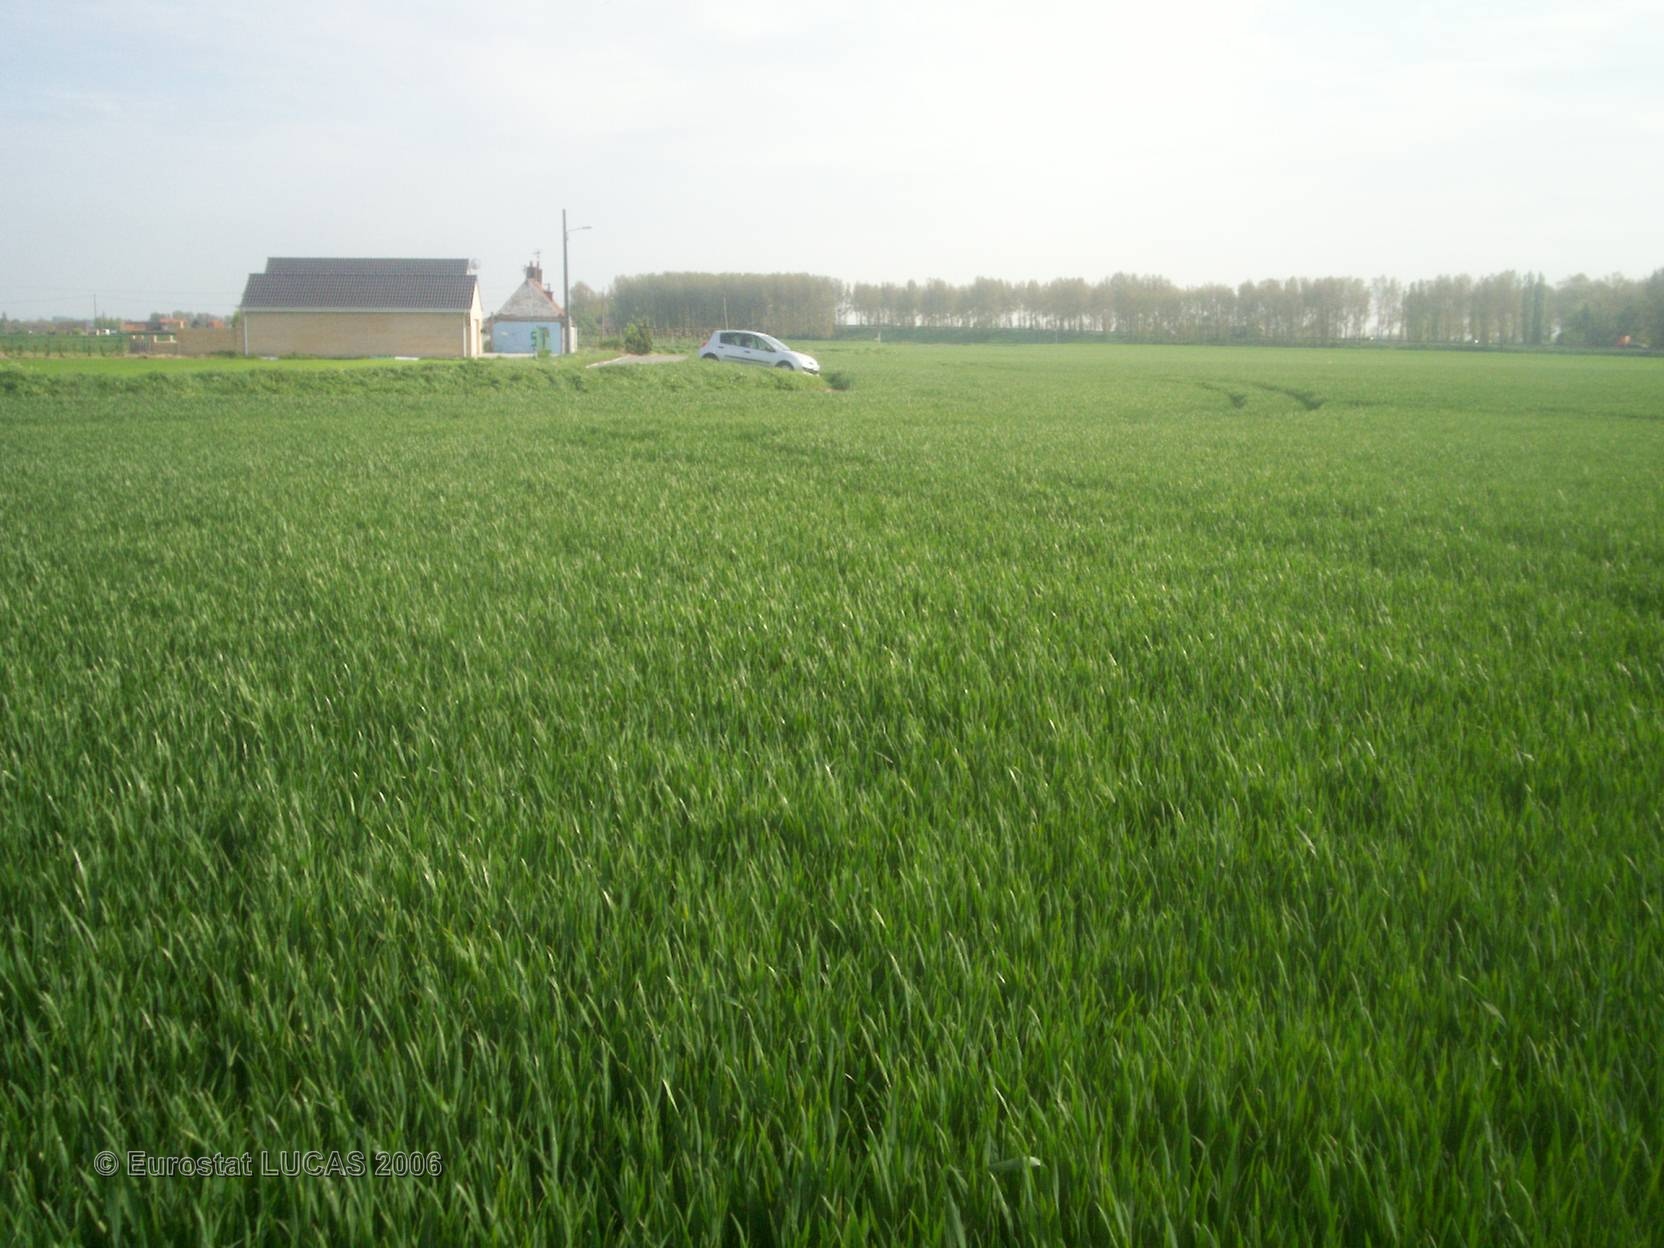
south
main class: Cropland
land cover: Common wheat
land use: Agriculture (excluding fallow land and kitchen gardens)
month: May
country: FR
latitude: 50.9776
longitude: 2.3952
